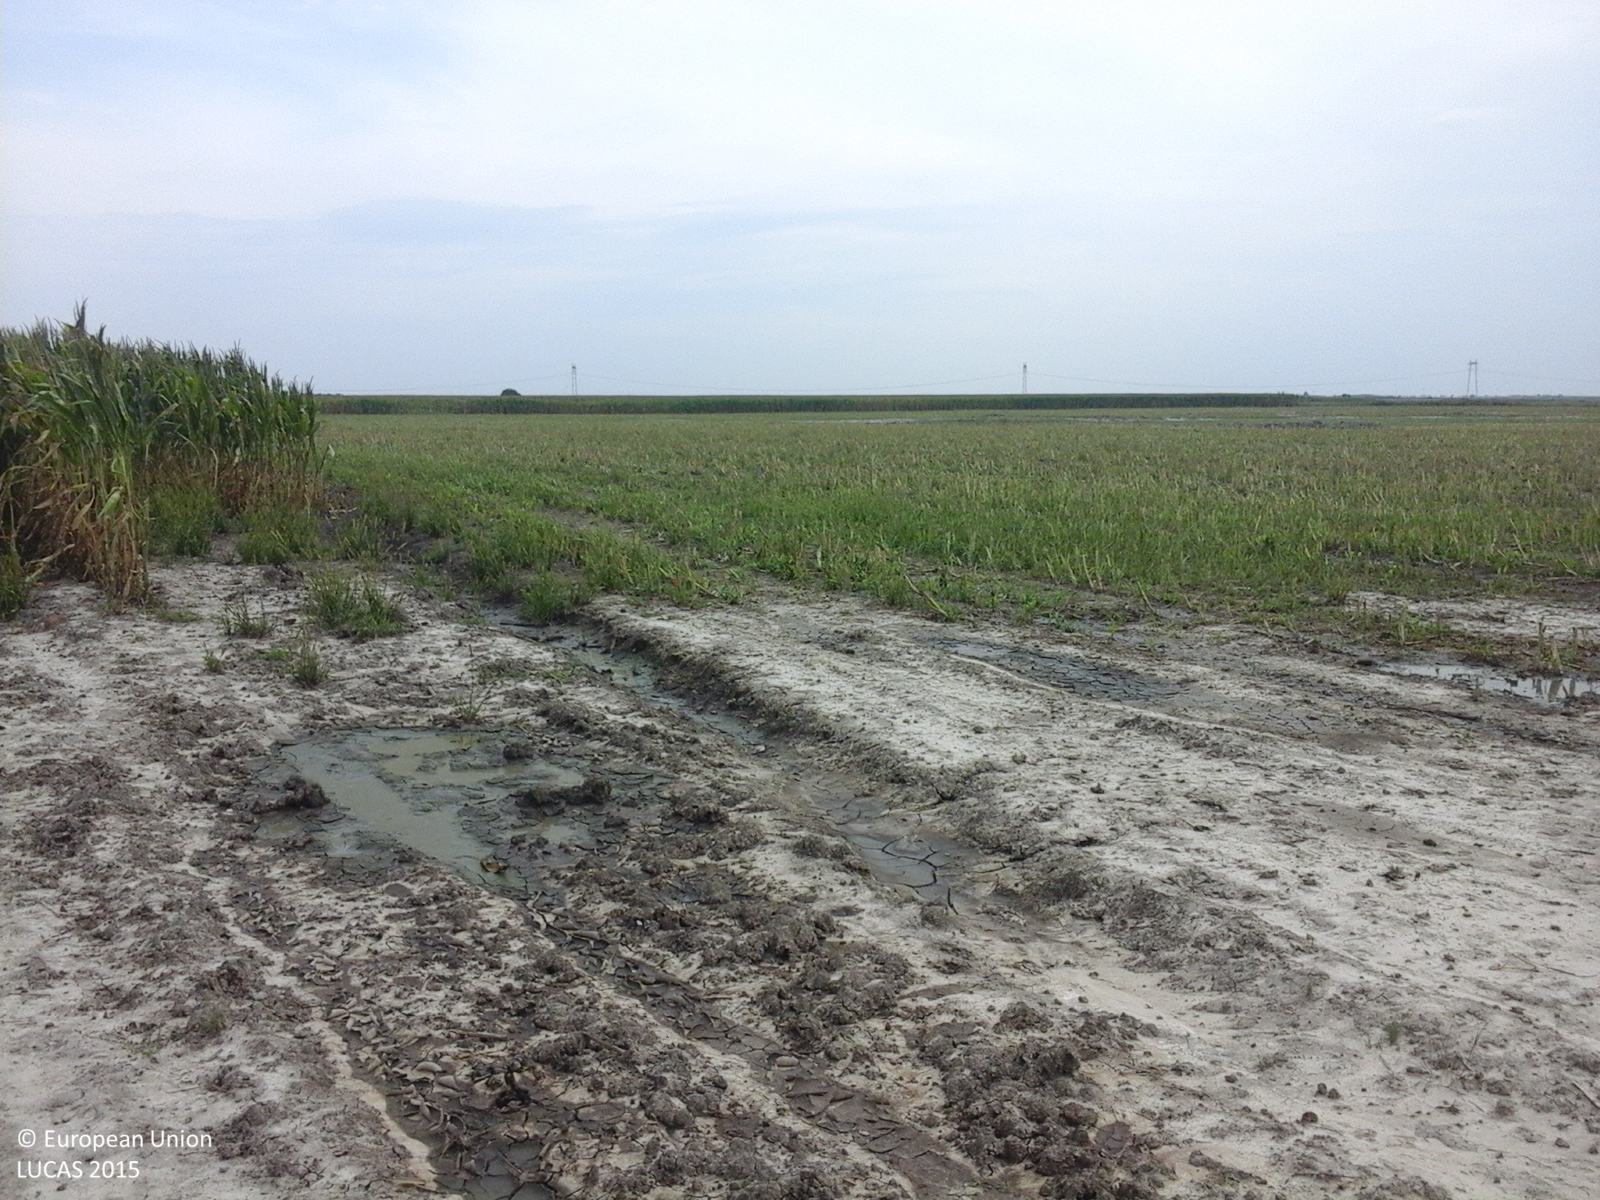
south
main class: Cropland
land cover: Maize
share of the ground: > 75 %
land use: Agriculture (excluding fallow land and kitchen gardens)
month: August
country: RO
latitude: 46.2516
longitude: 21.2013
